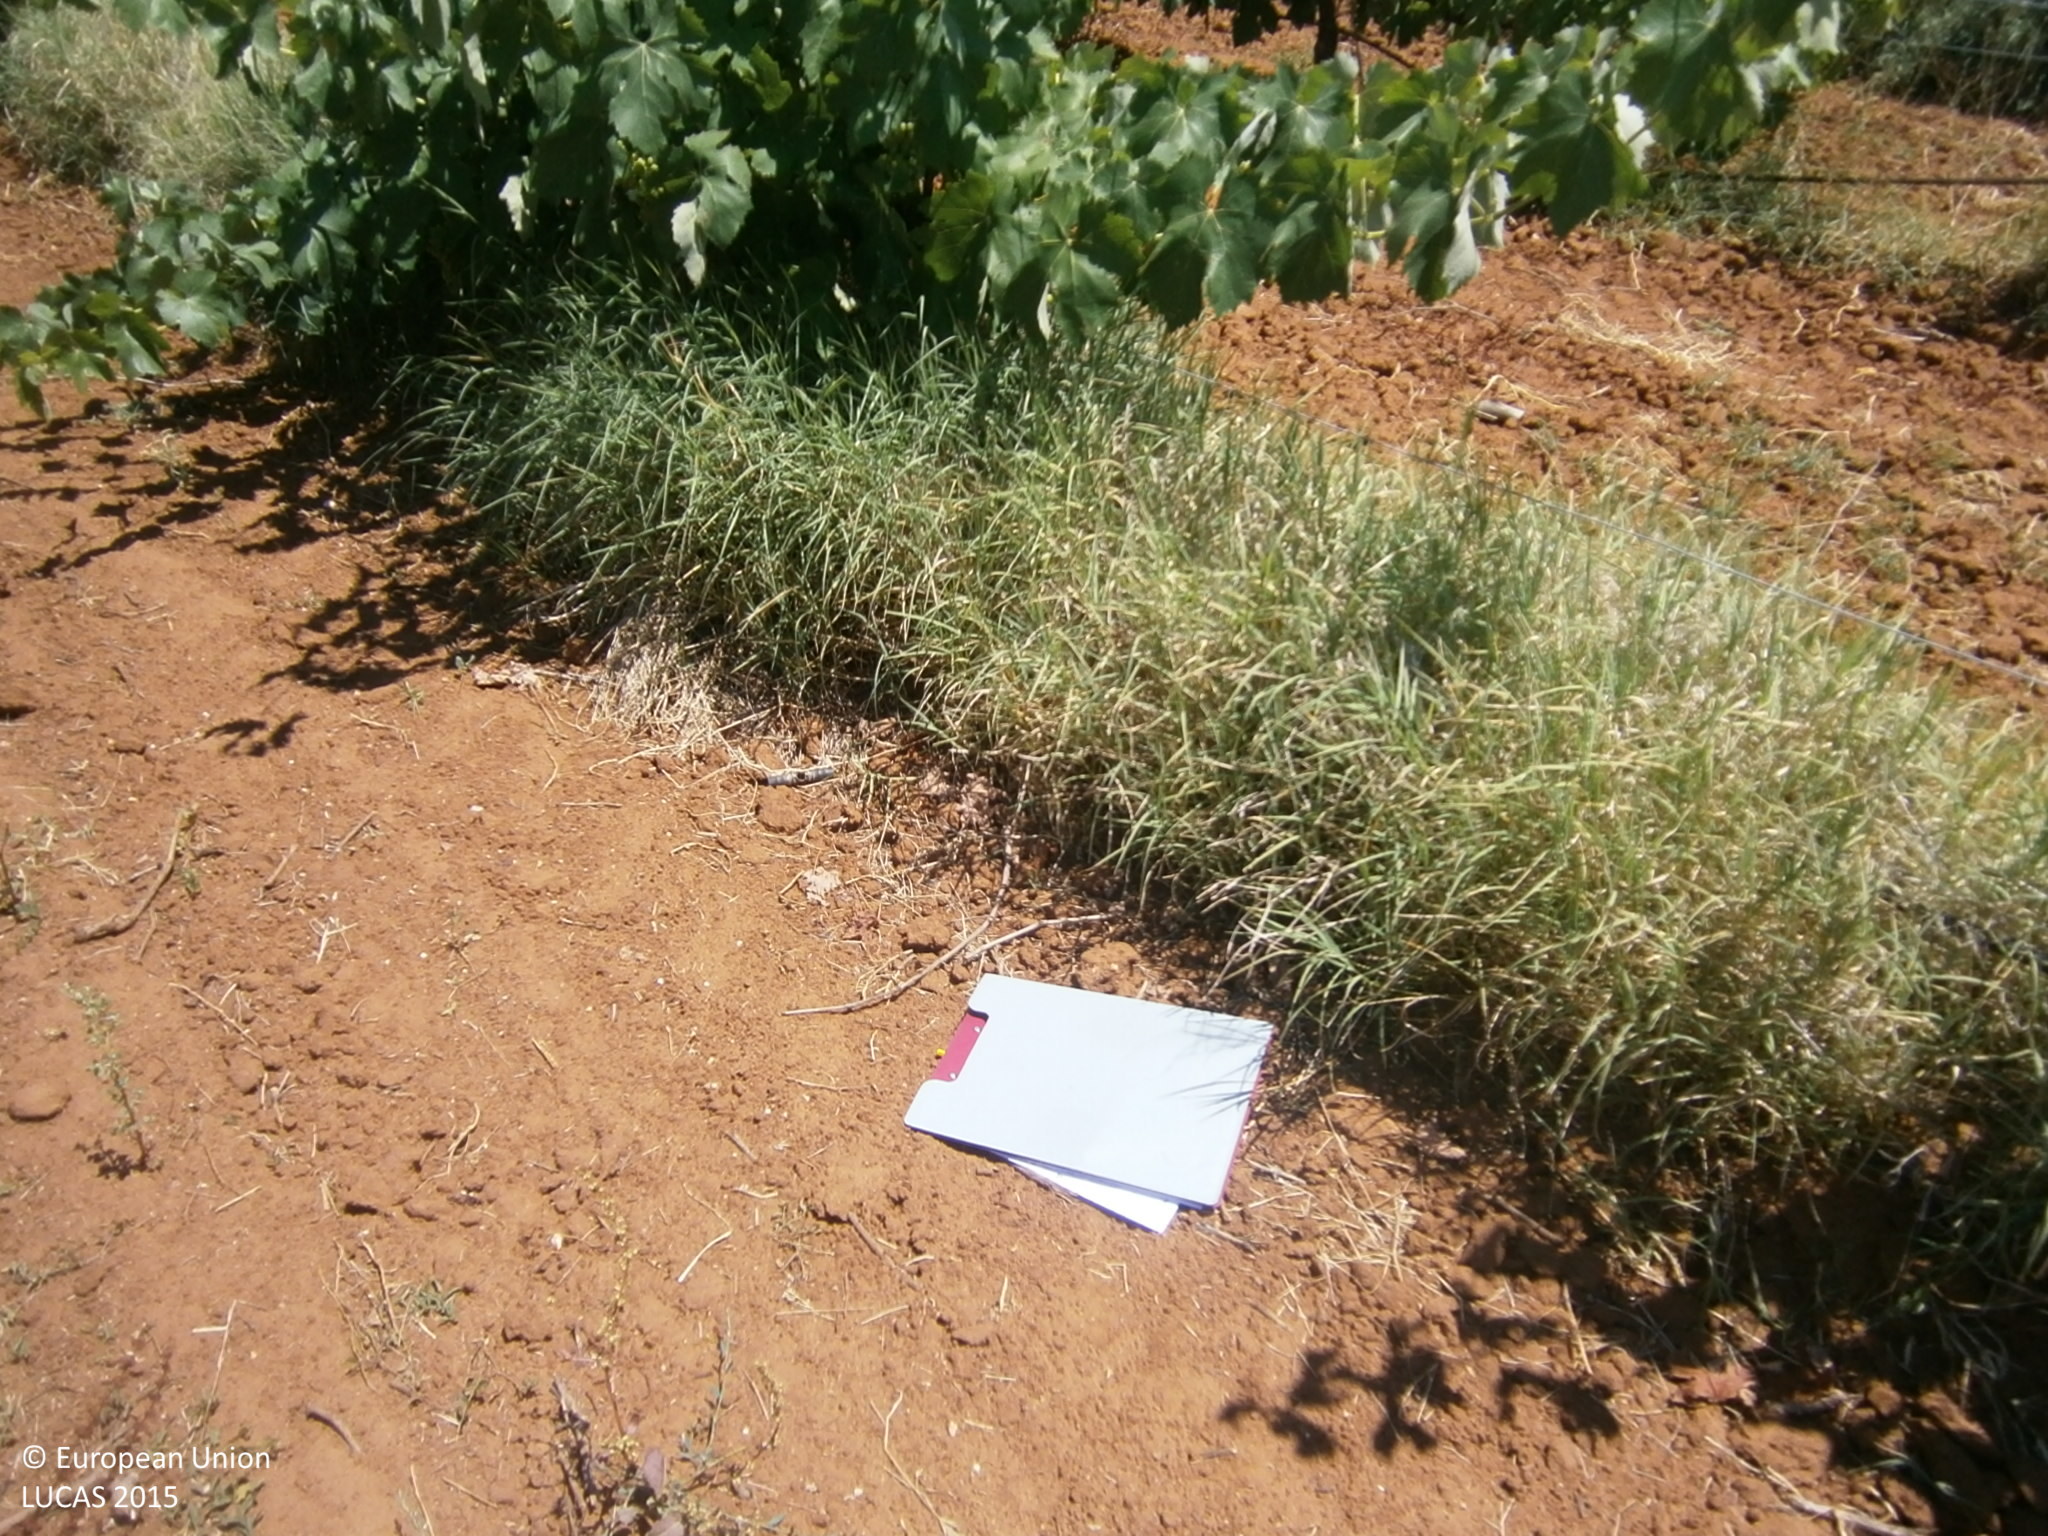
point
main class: Cropland
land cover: Vineyards
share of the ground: 50 - 75 %
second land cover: Spontaneously vegetated surfaces
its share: 10 - 25 %
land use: Agriculture (excluding fallow land and kitchen gardens)
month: June
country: ES
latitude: 38.7783
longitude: -6.6484
